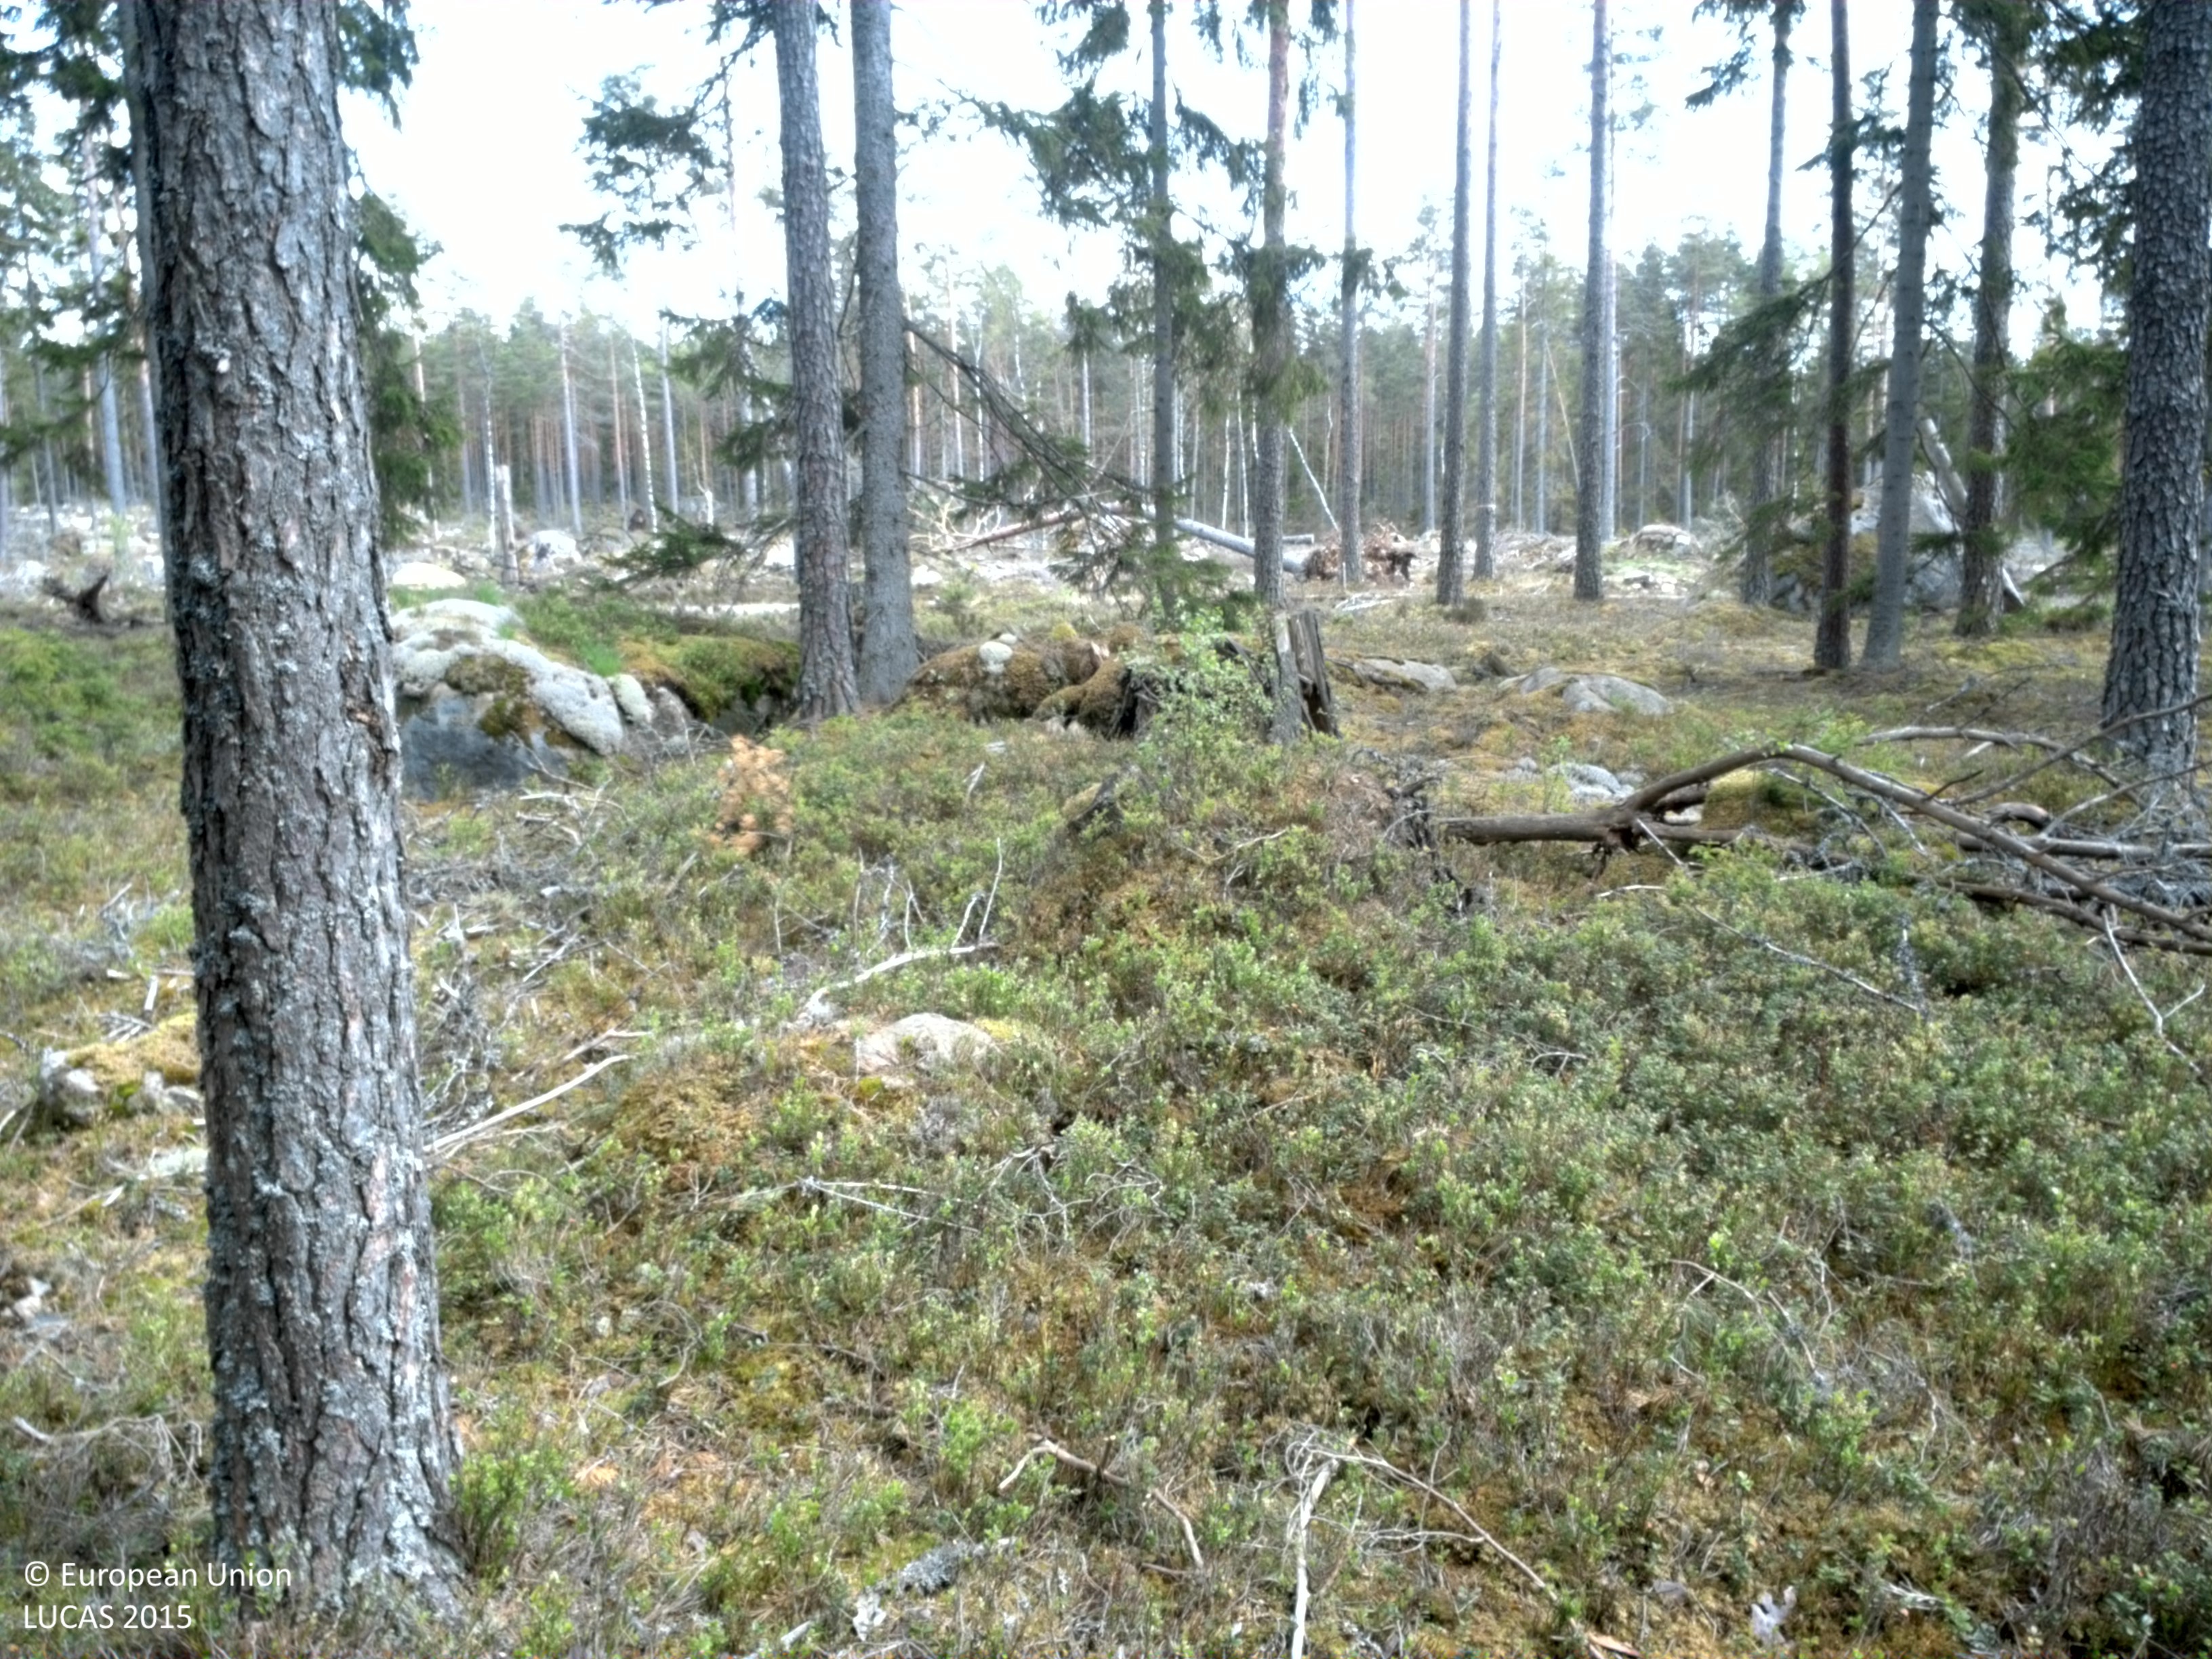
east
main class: Woodland
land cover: Pine dominated coniferous woodland
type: boreal forest
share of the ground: 50 - 75 %
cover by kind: coniferous forest trees 40 %, shrubs 35 %, lichens and mosses 15 %, broadleaved forest trees 10 %
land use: Forestry
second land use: Amenities, museums, leisure
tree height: > 5 m
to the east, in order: Pine dominated coniferous woodland; Paved roads, cycling and walking lanes; Shrubland with sparse tree cover; Pine dominated coniferous woodland
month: May
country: SE
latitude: 56.8229
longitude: 15.1590
